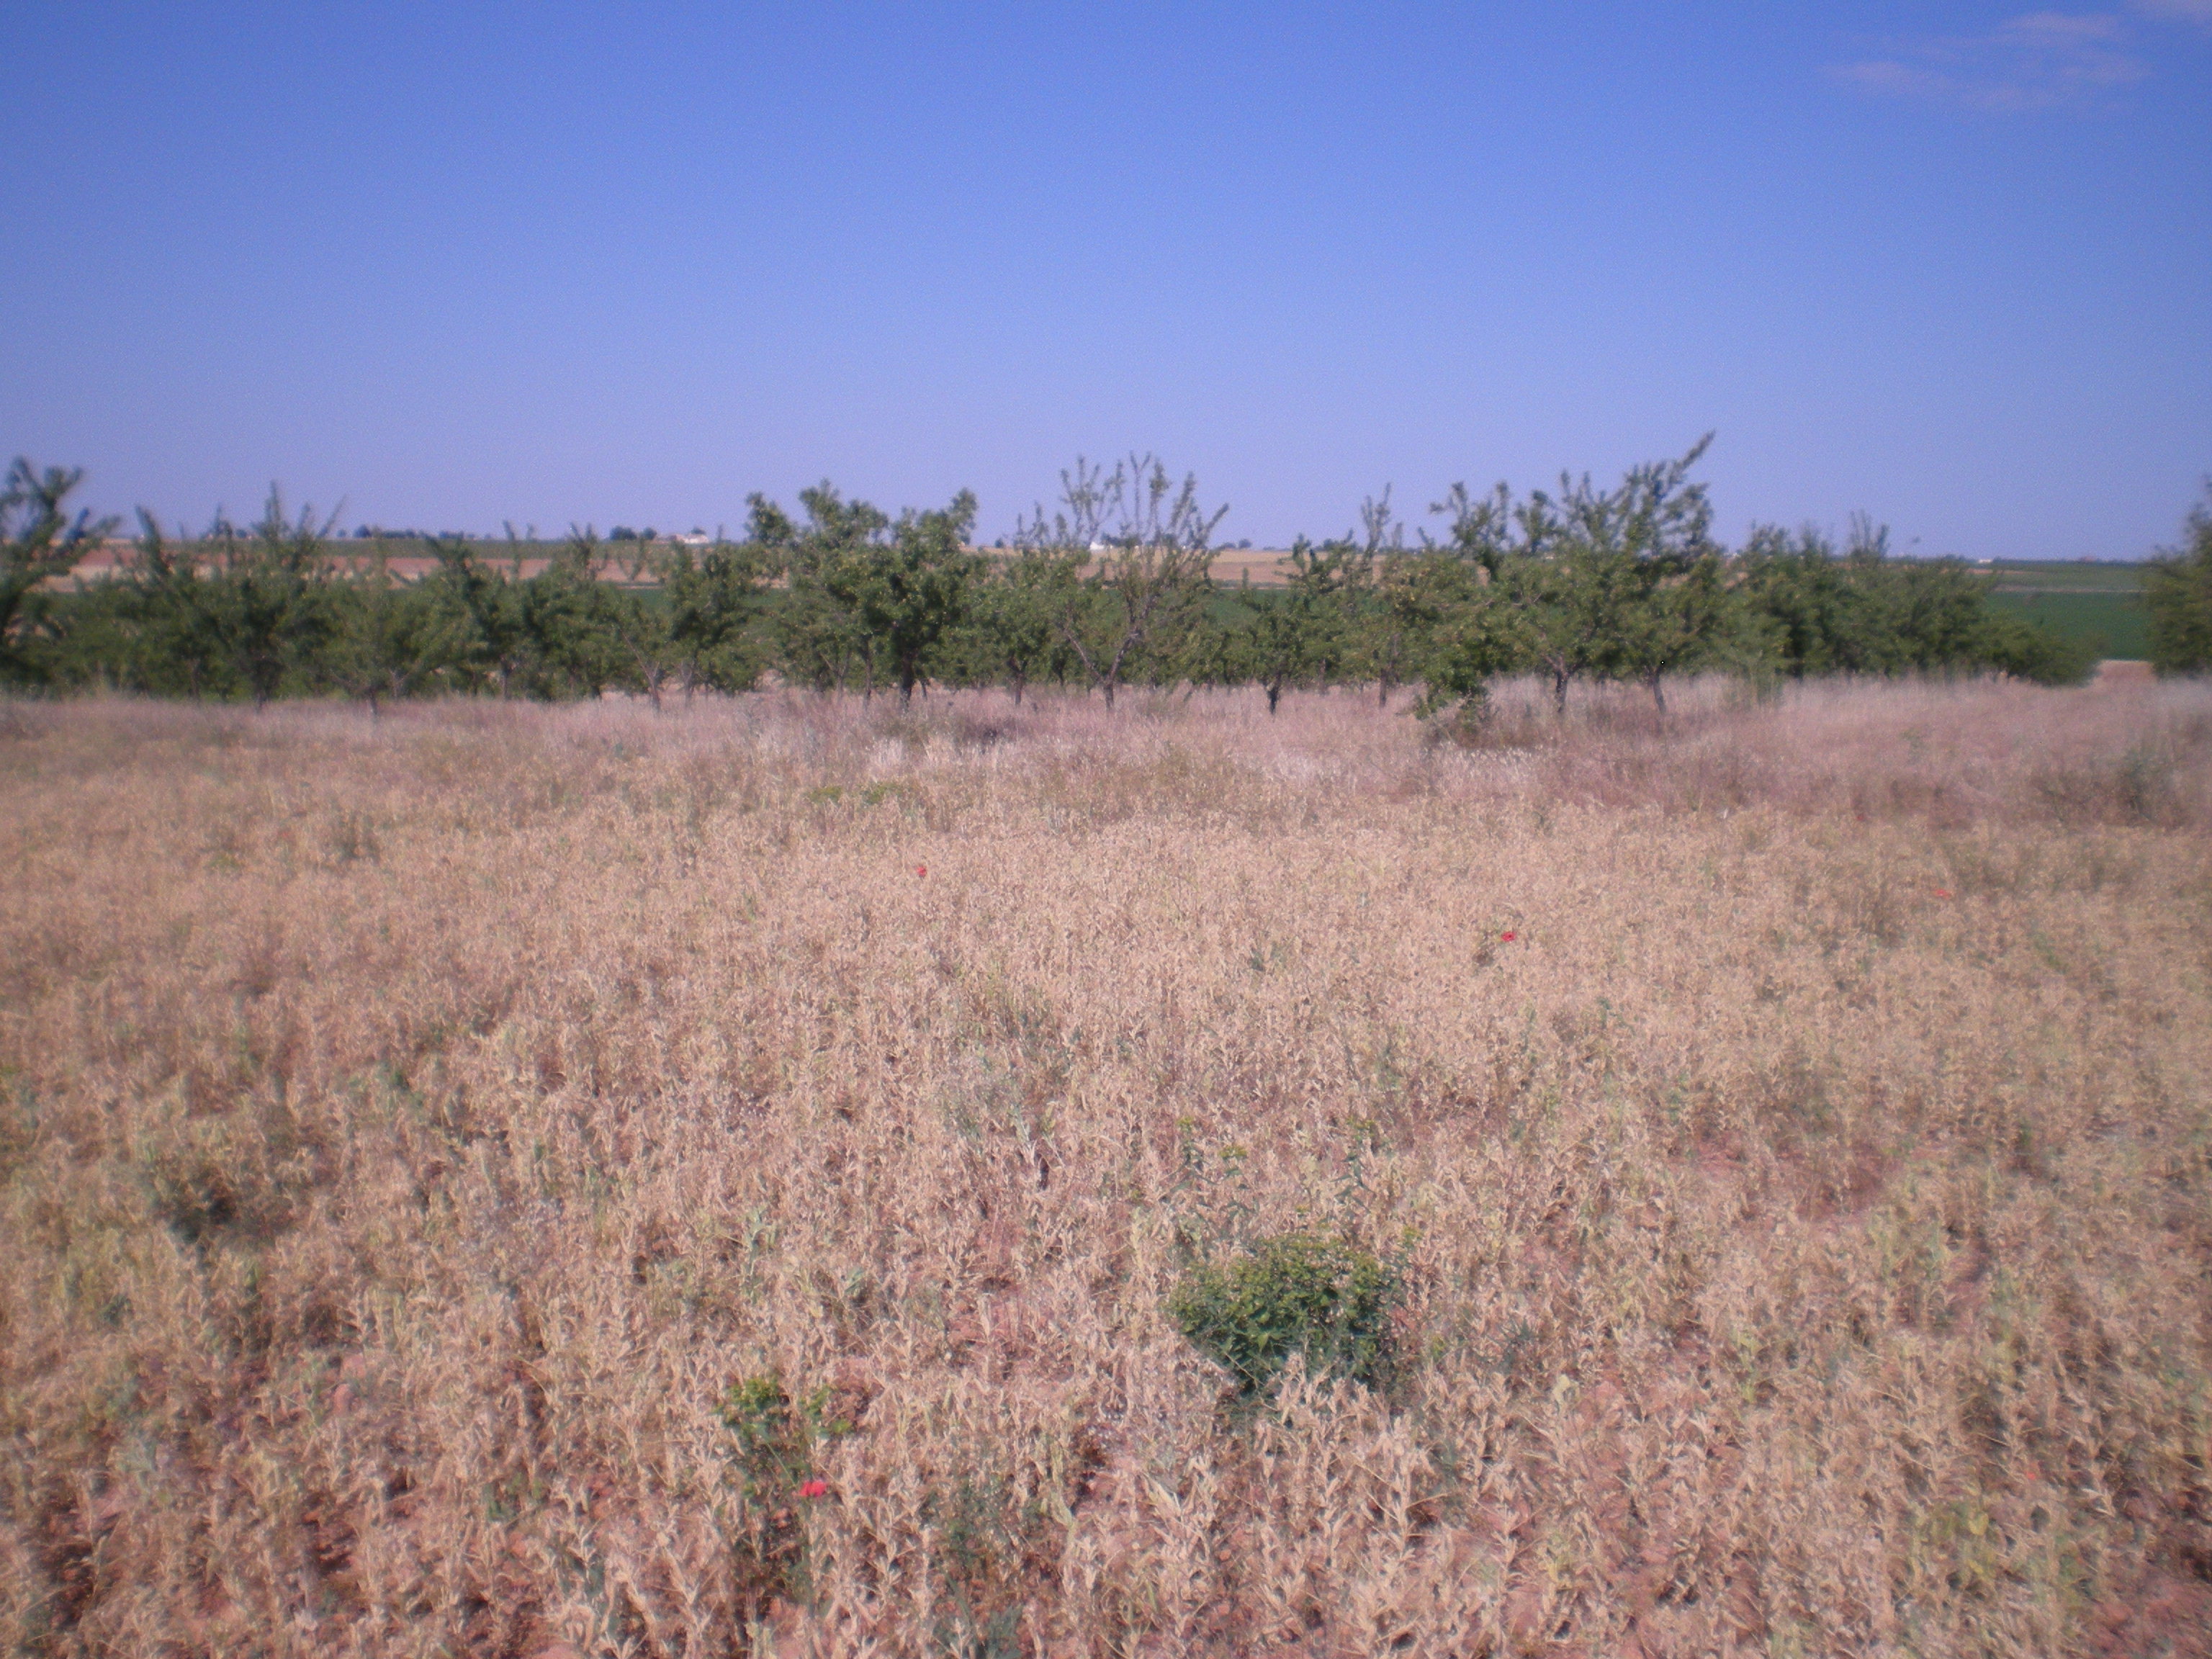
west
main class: Cropland
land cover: Dry pulses
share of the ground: > 75 %
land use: Agriculture (excluding fallow land and kitchen gardens)
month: May
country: ES
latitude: 39.0106
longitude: -3.4226
